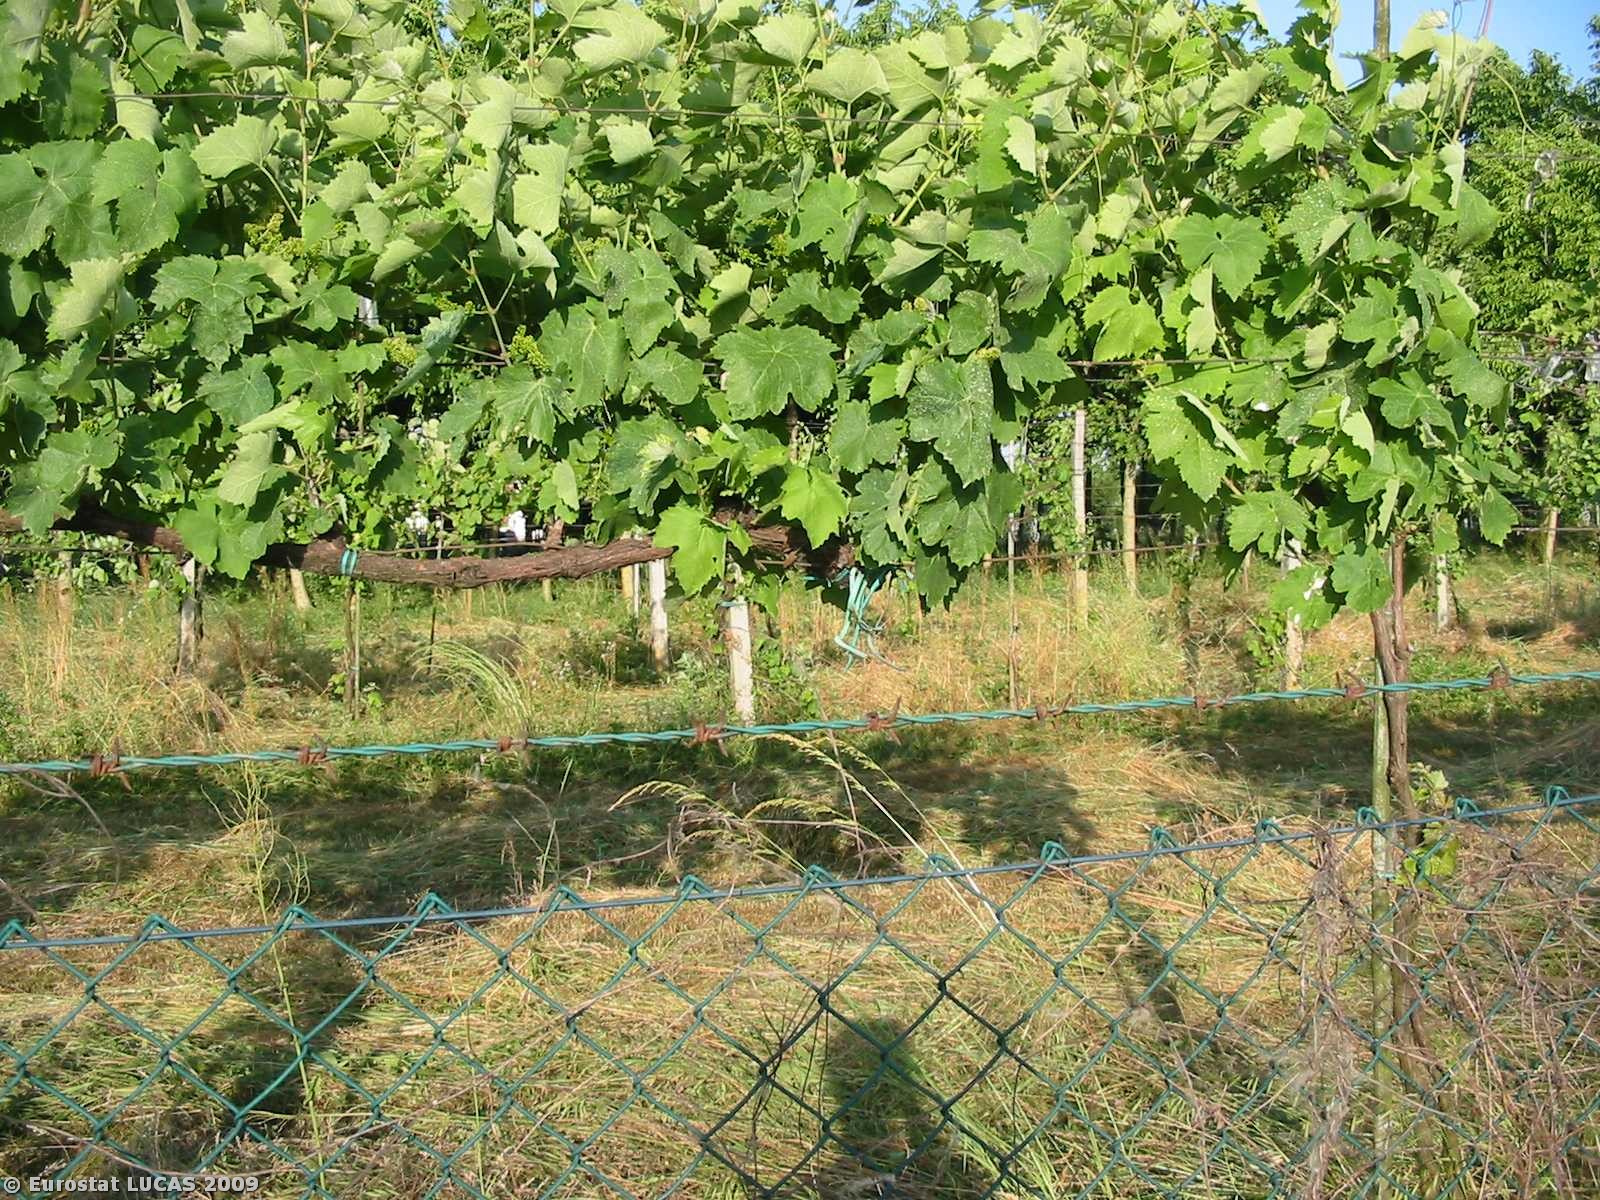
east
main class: Cropland
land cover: Vineyards
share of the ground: 10 - 25 %
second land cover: Grassland with sparse tree/shrub cover
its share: > 75 %
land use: Agriculture (excluding fallow land and kitchen gardens)
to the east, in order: Vineyards; Grassland with sparse tree/shrub cover; Nuts trees; Grassland with sparse tree/shrub cover; Fences; Tracks; Lucerne; Maize; Grass margins; Tracks; Grassland without tree/shrub cover; Artificial constructions in urban areas; Grassland with sparse tree/shrub cover; Ditches and canals; Mixed cereals for fodder; Maize
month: May
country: IT
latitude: 45.7069
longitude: 11.7058
